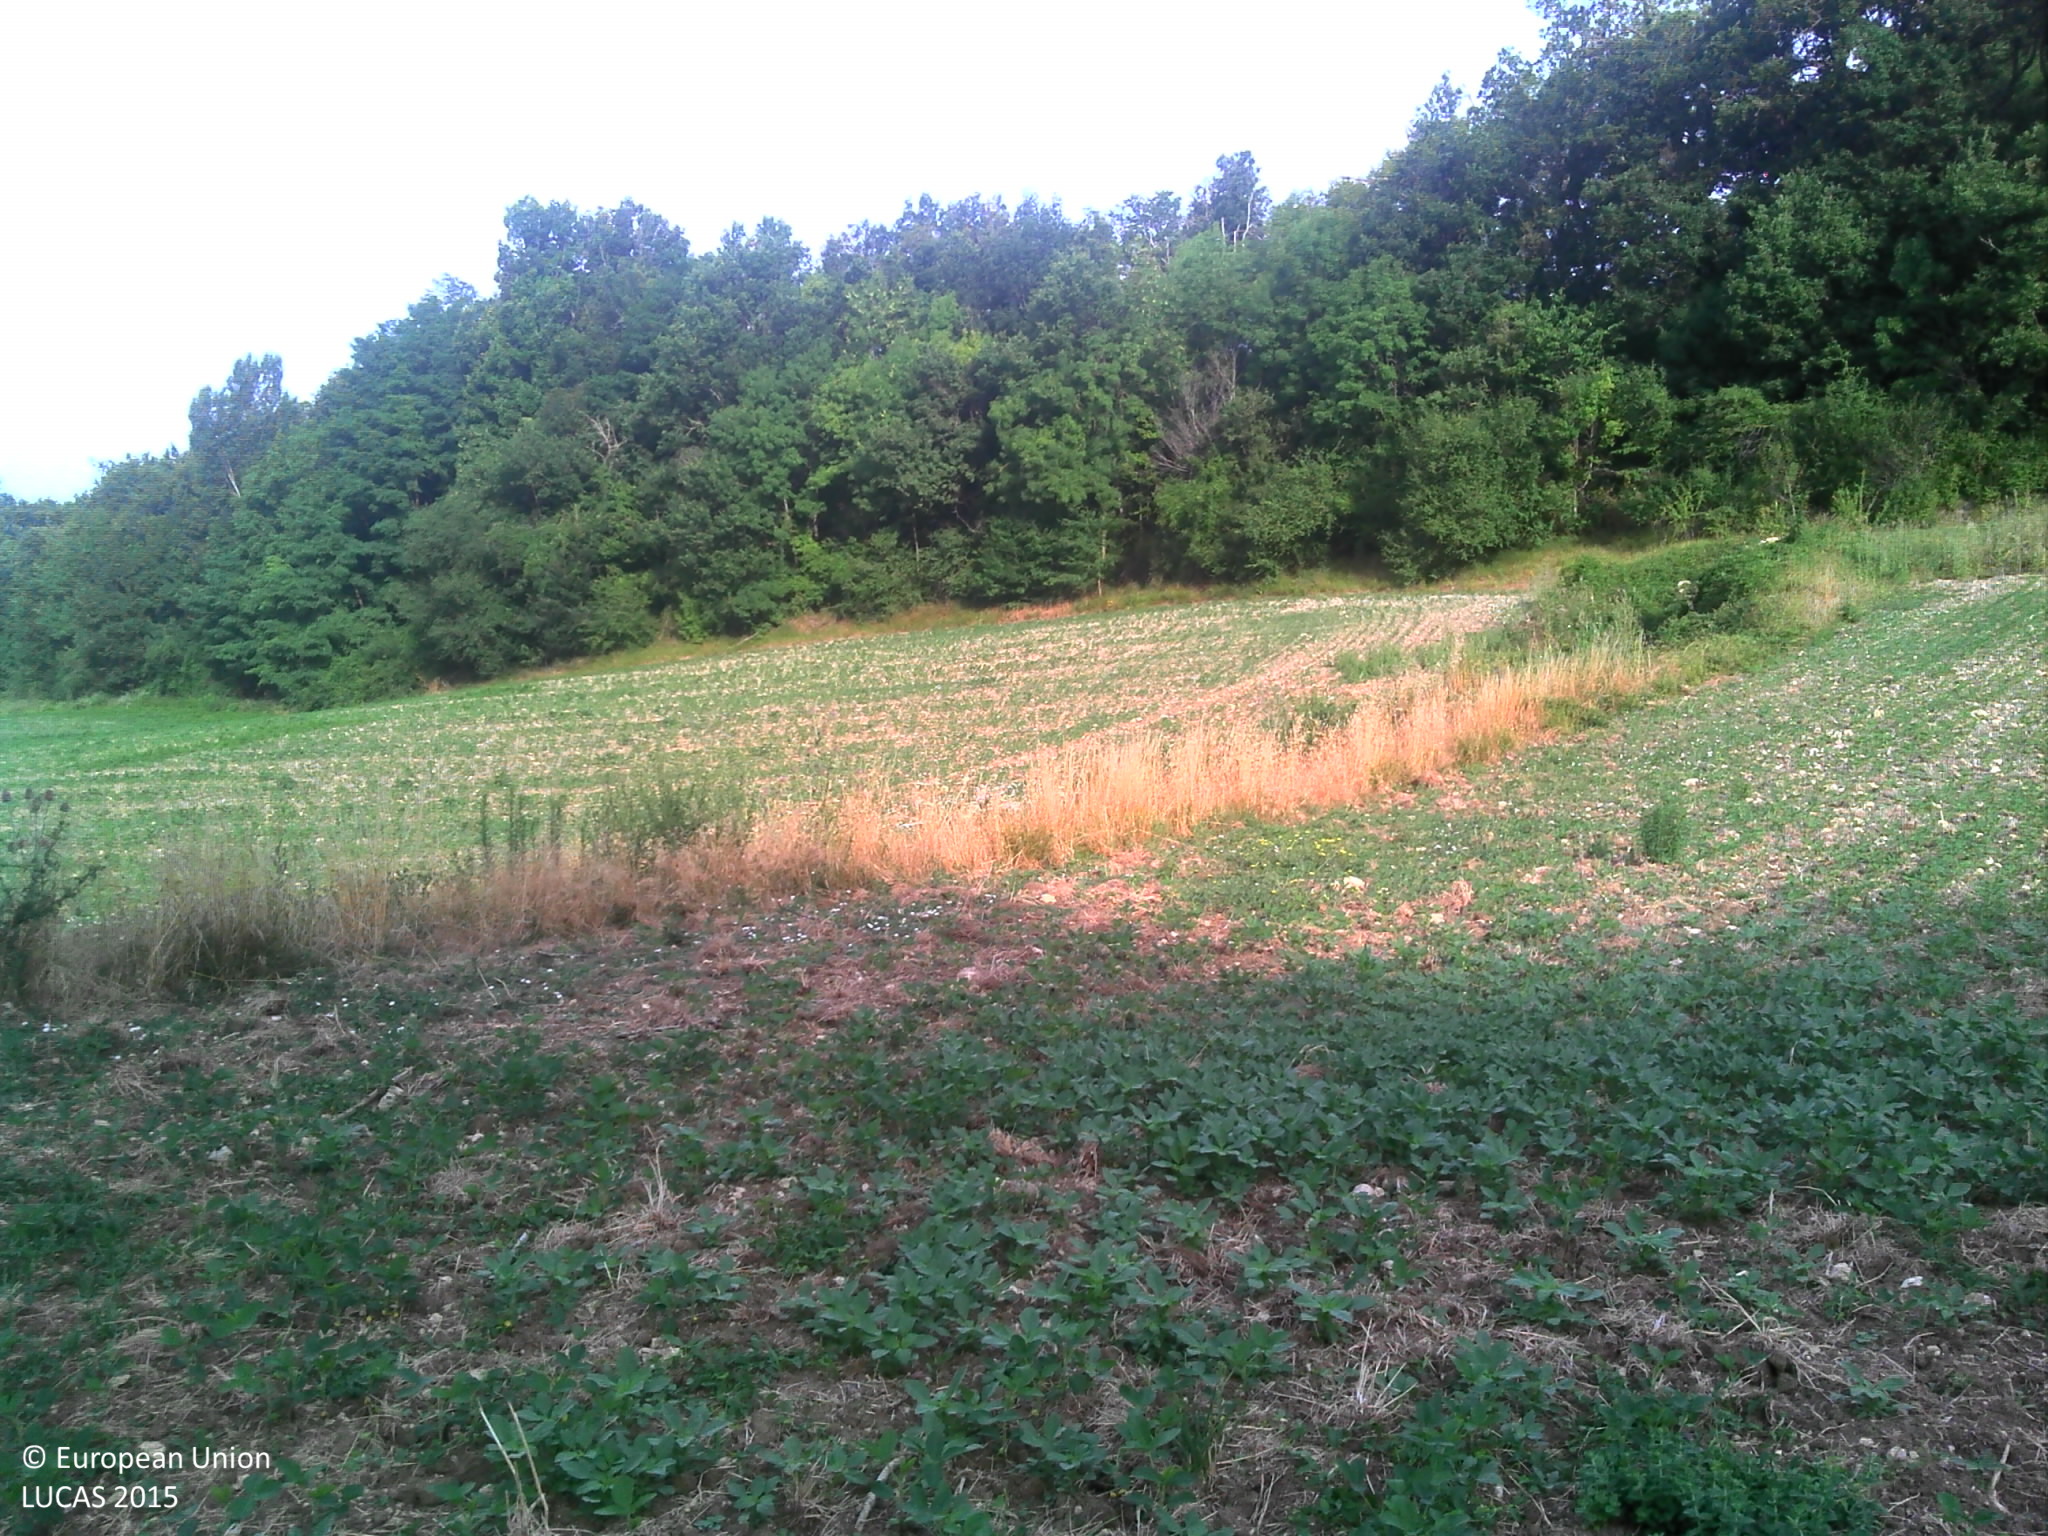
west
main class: Cropland
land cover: Soya
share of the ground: > 75 %
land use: Agriculture (excluding fallow land and kitchen gardens)
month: July
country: FR
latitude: 44.3134
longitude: 0.9065
